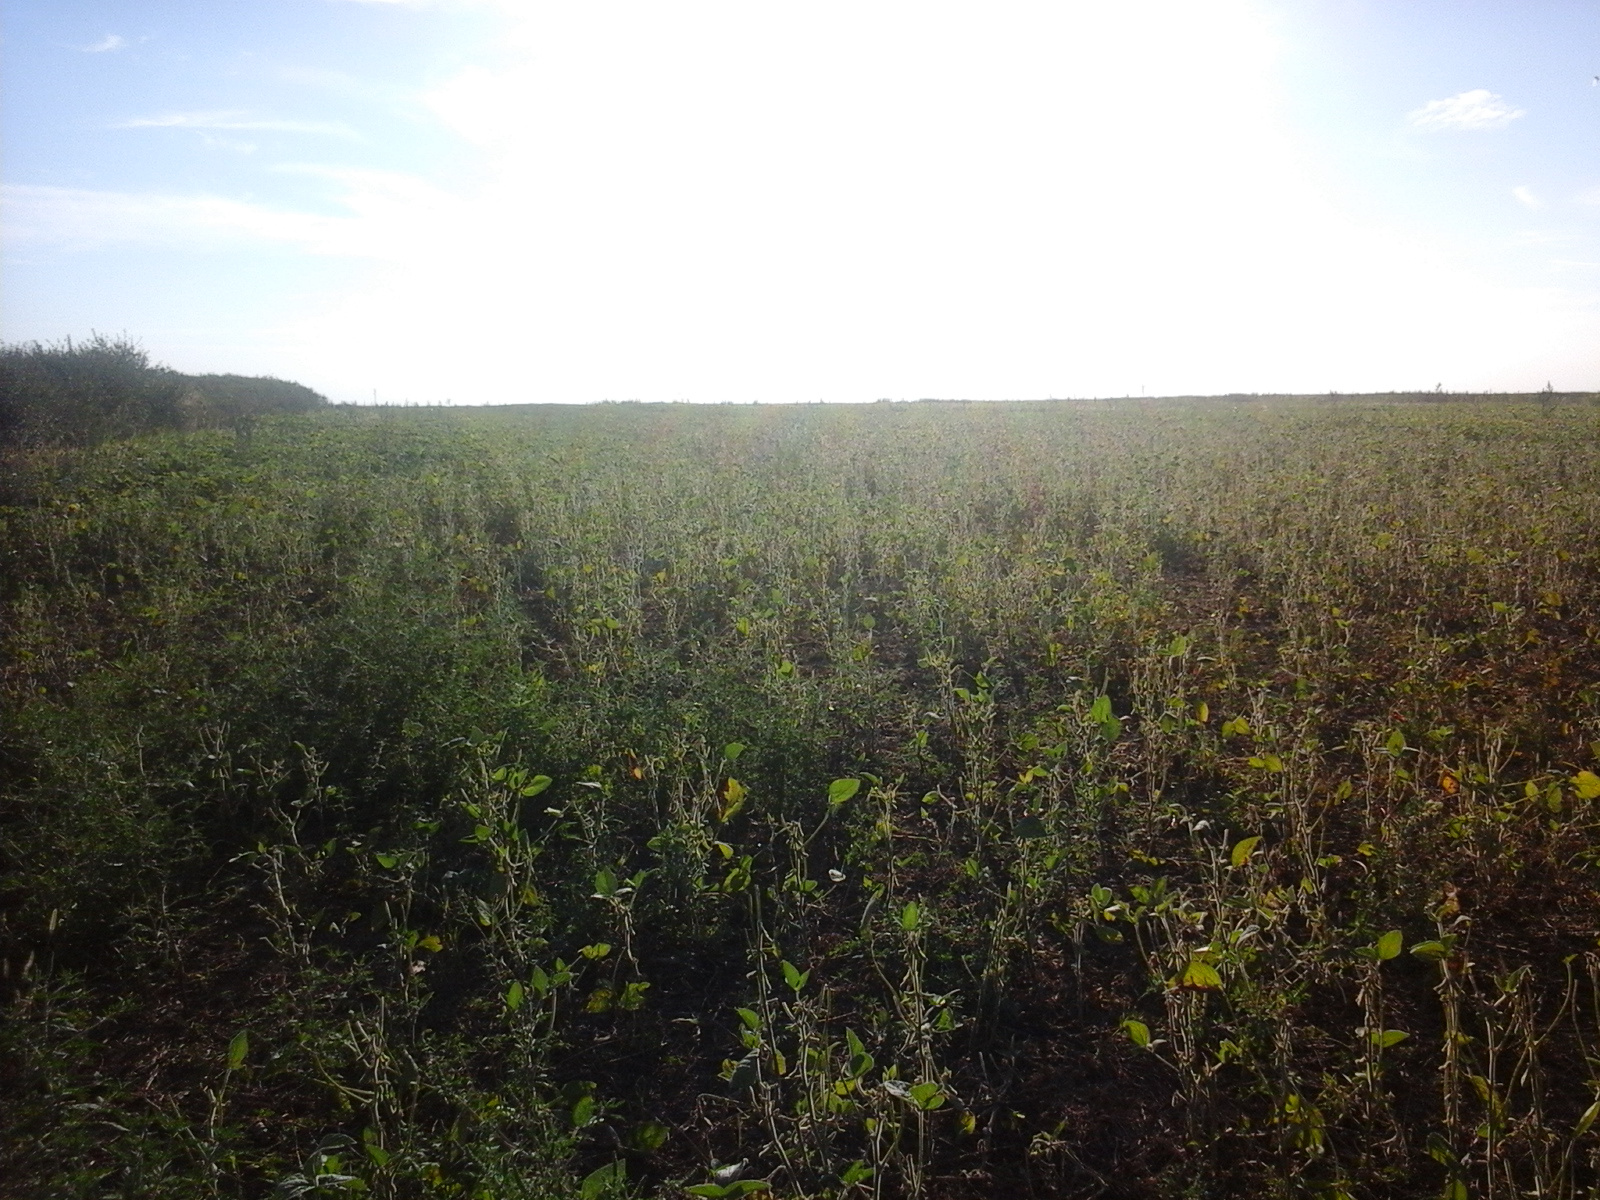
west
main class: Cropland
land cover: Soya
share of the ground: > 75 %
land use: Agriculture (excluding fallow land and kitchen gardens)
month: August
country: RO
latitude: 45.9809
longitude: 21.3536
